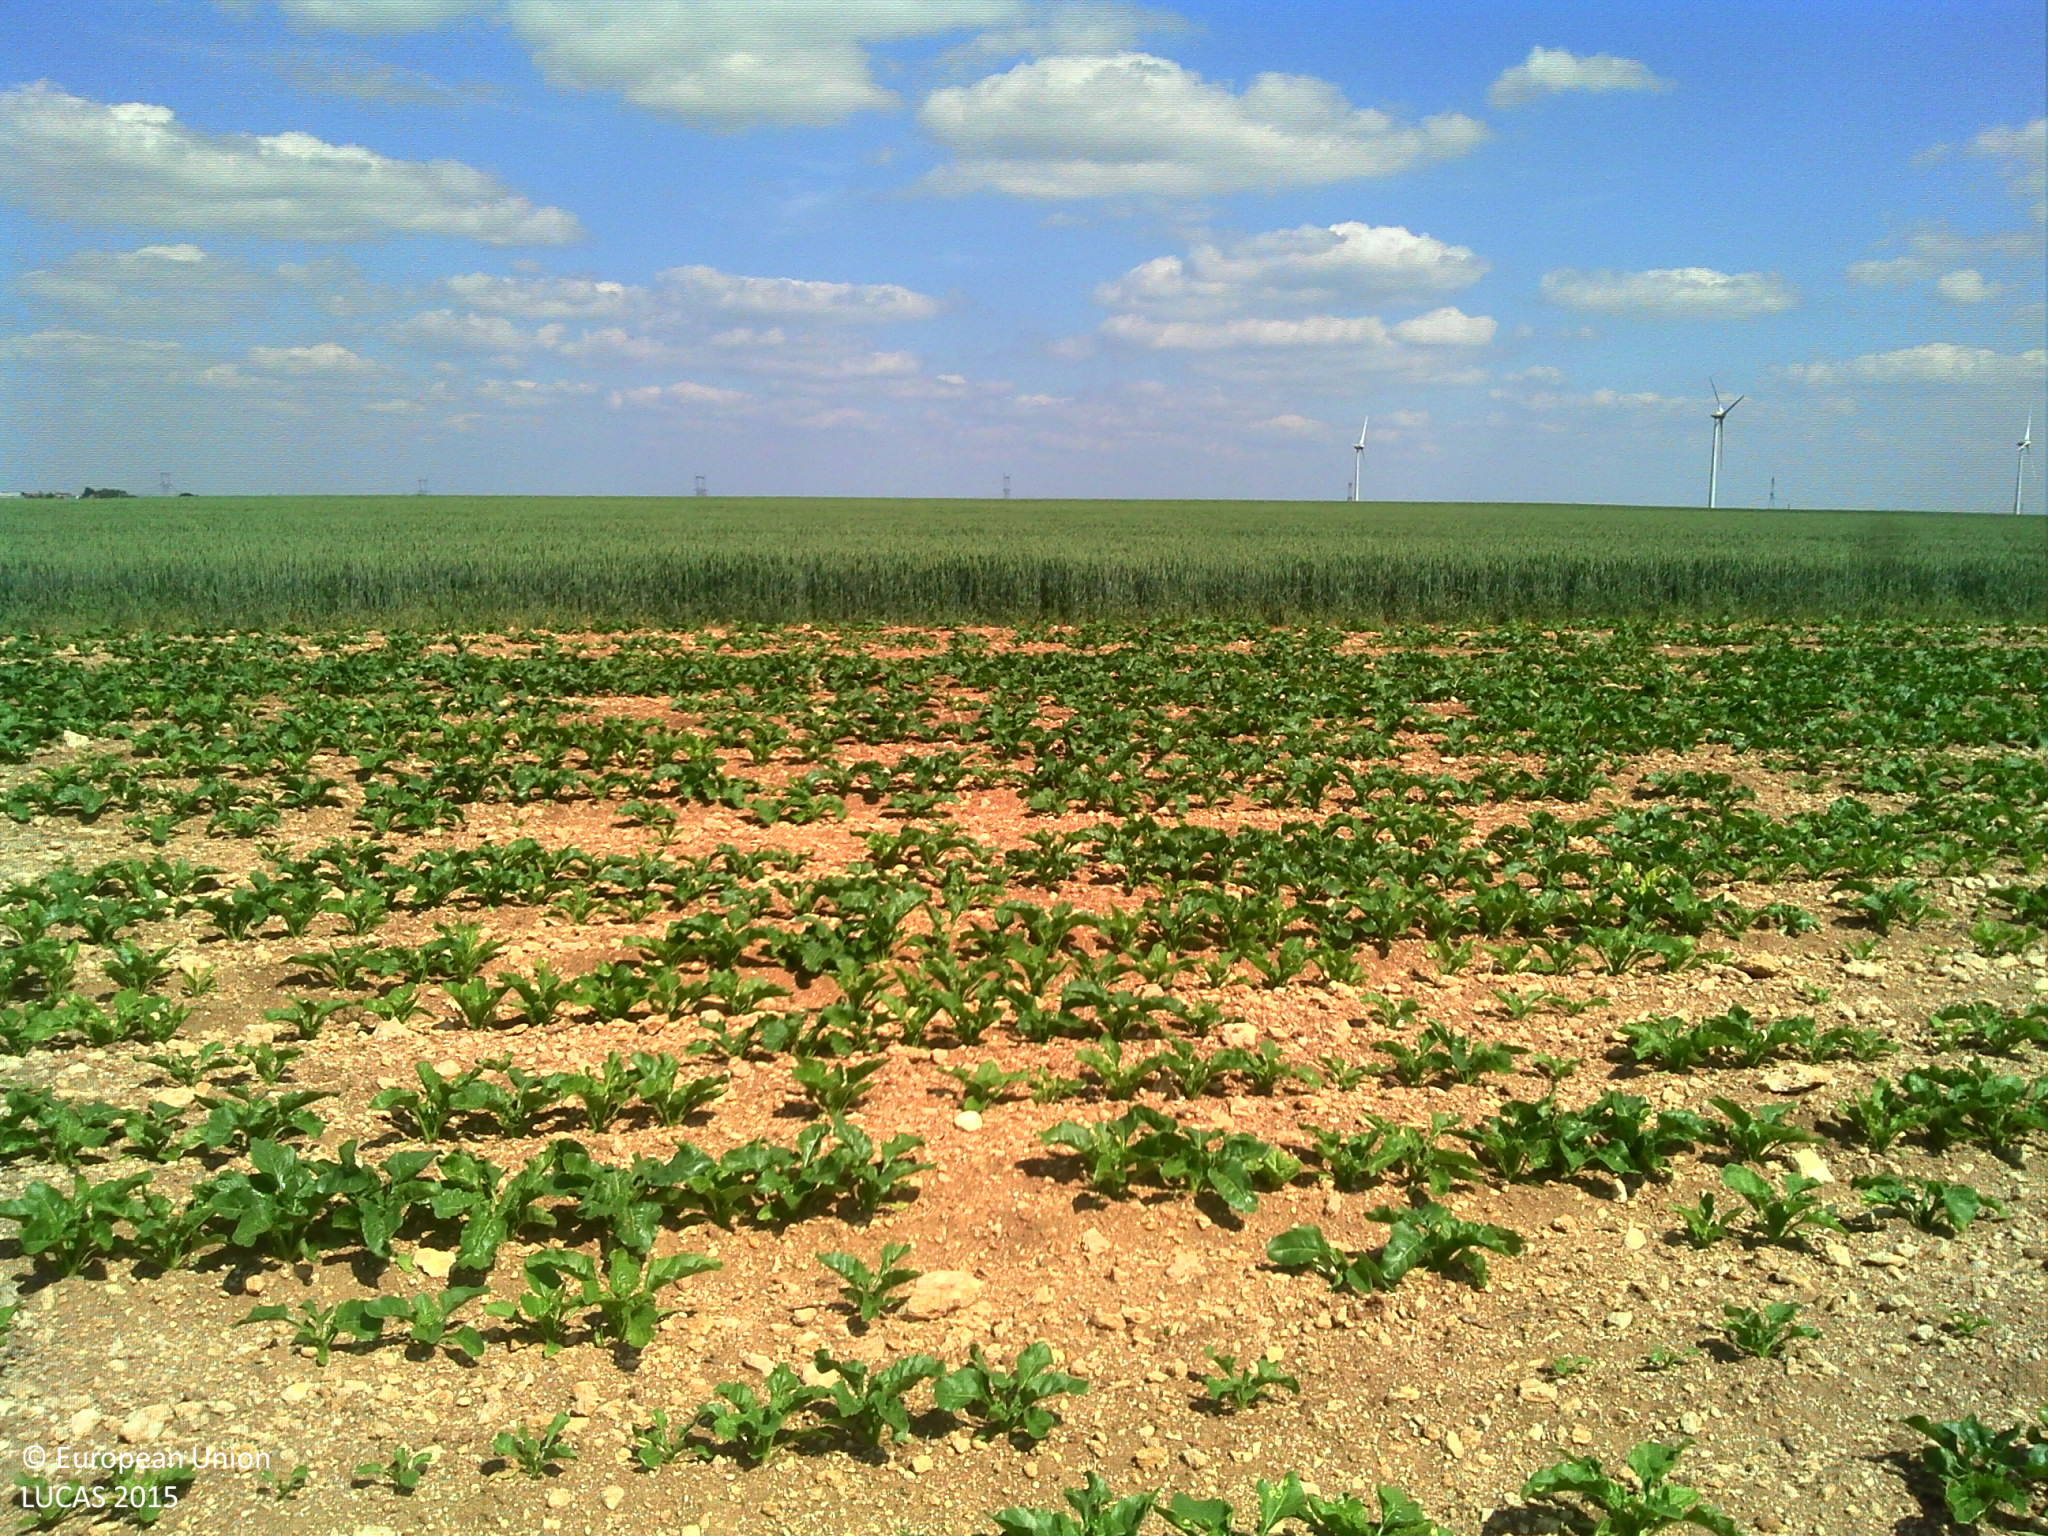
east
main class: Cropland
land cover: Sugar beet
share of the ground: 10 - 25 %
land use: Agriculture (excluding fallow land and kitchen gardens)
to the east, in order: Sugar beet; Electric lines; Common wheat
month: May
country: FR
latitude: 48.2699
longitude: 1.9162
